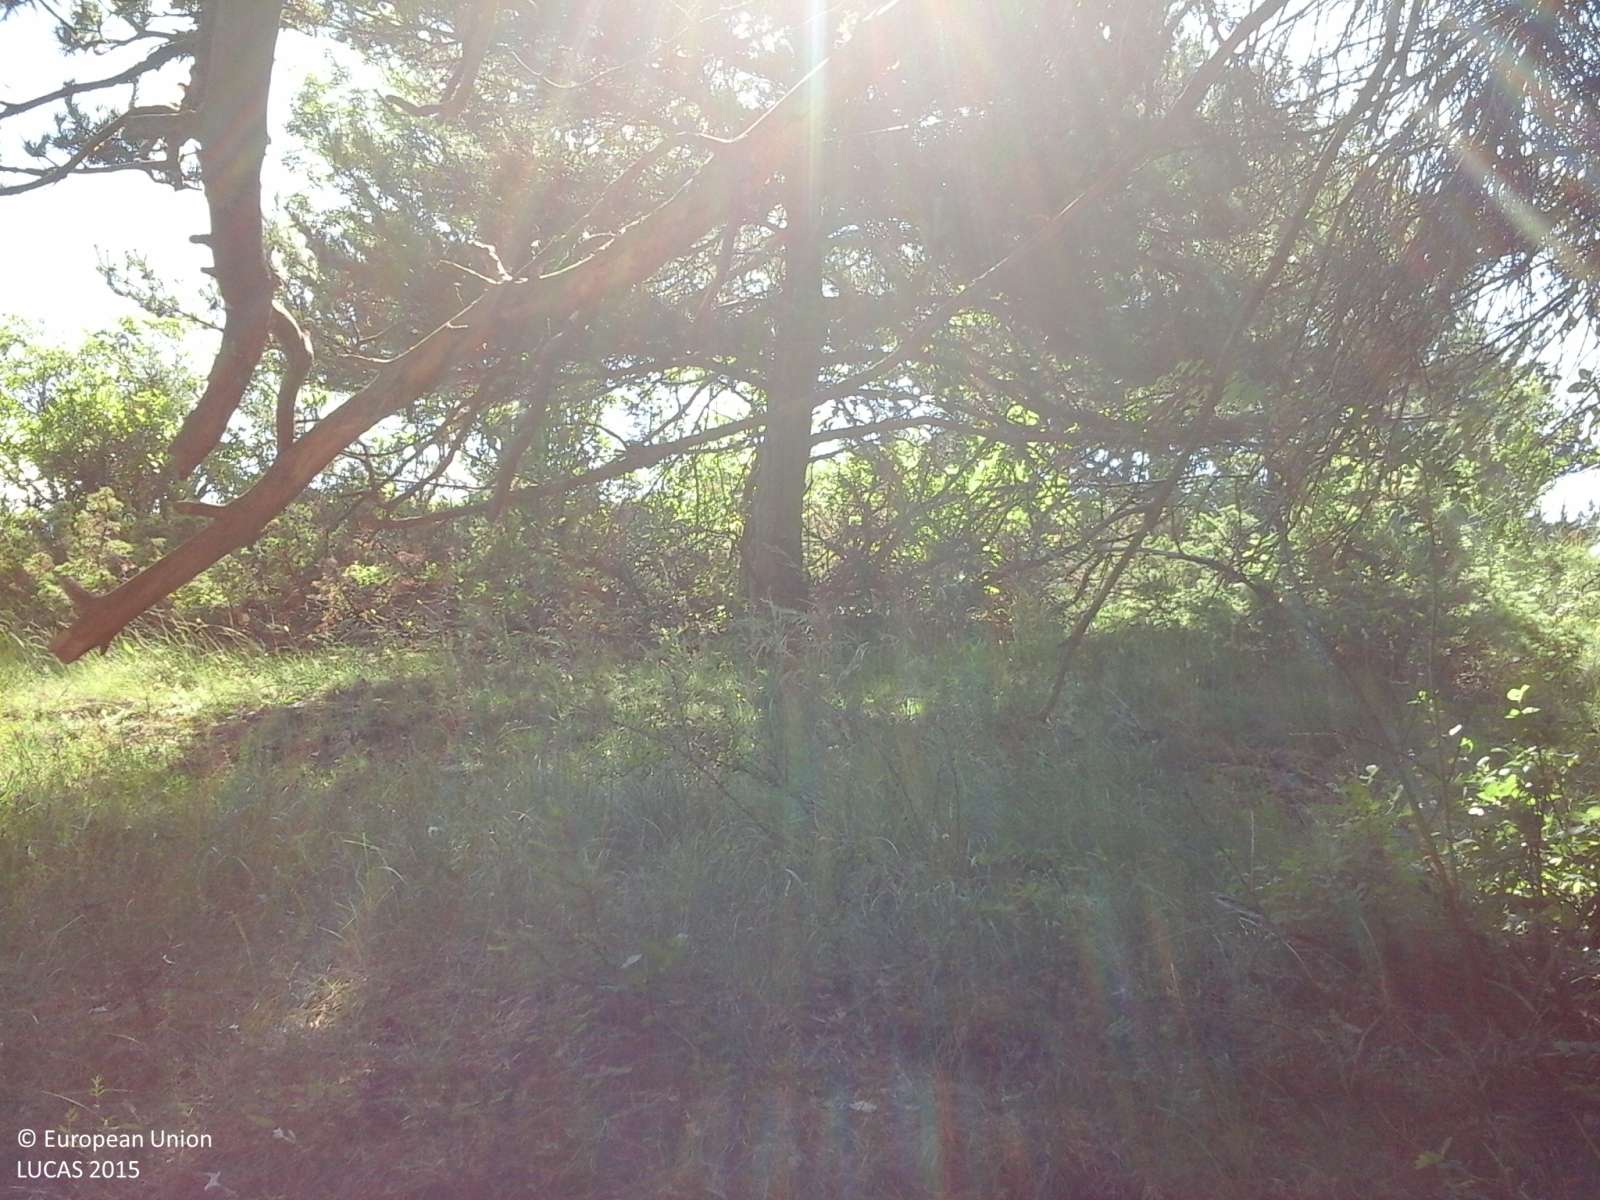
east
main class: Woodland
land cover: Pine dominated coniferous woodland
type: alpine coniferous forest
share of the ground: > 75 %
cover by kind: coniferous forest trees 100 %
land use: Semi-natural and natural areas not in use
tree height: > 5 m
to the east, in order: Pine dominated coniferous woodland; Grass margins; Paved roads, cycling and walking lanes; Grass margins; Pine dominated coniferous woodland; Shrubland with sparse tree cover; Grassland without tree/shrub cover; Pine dominated coniferous woodland
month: June
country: IT
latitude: 45.0401
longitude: 6.7680
